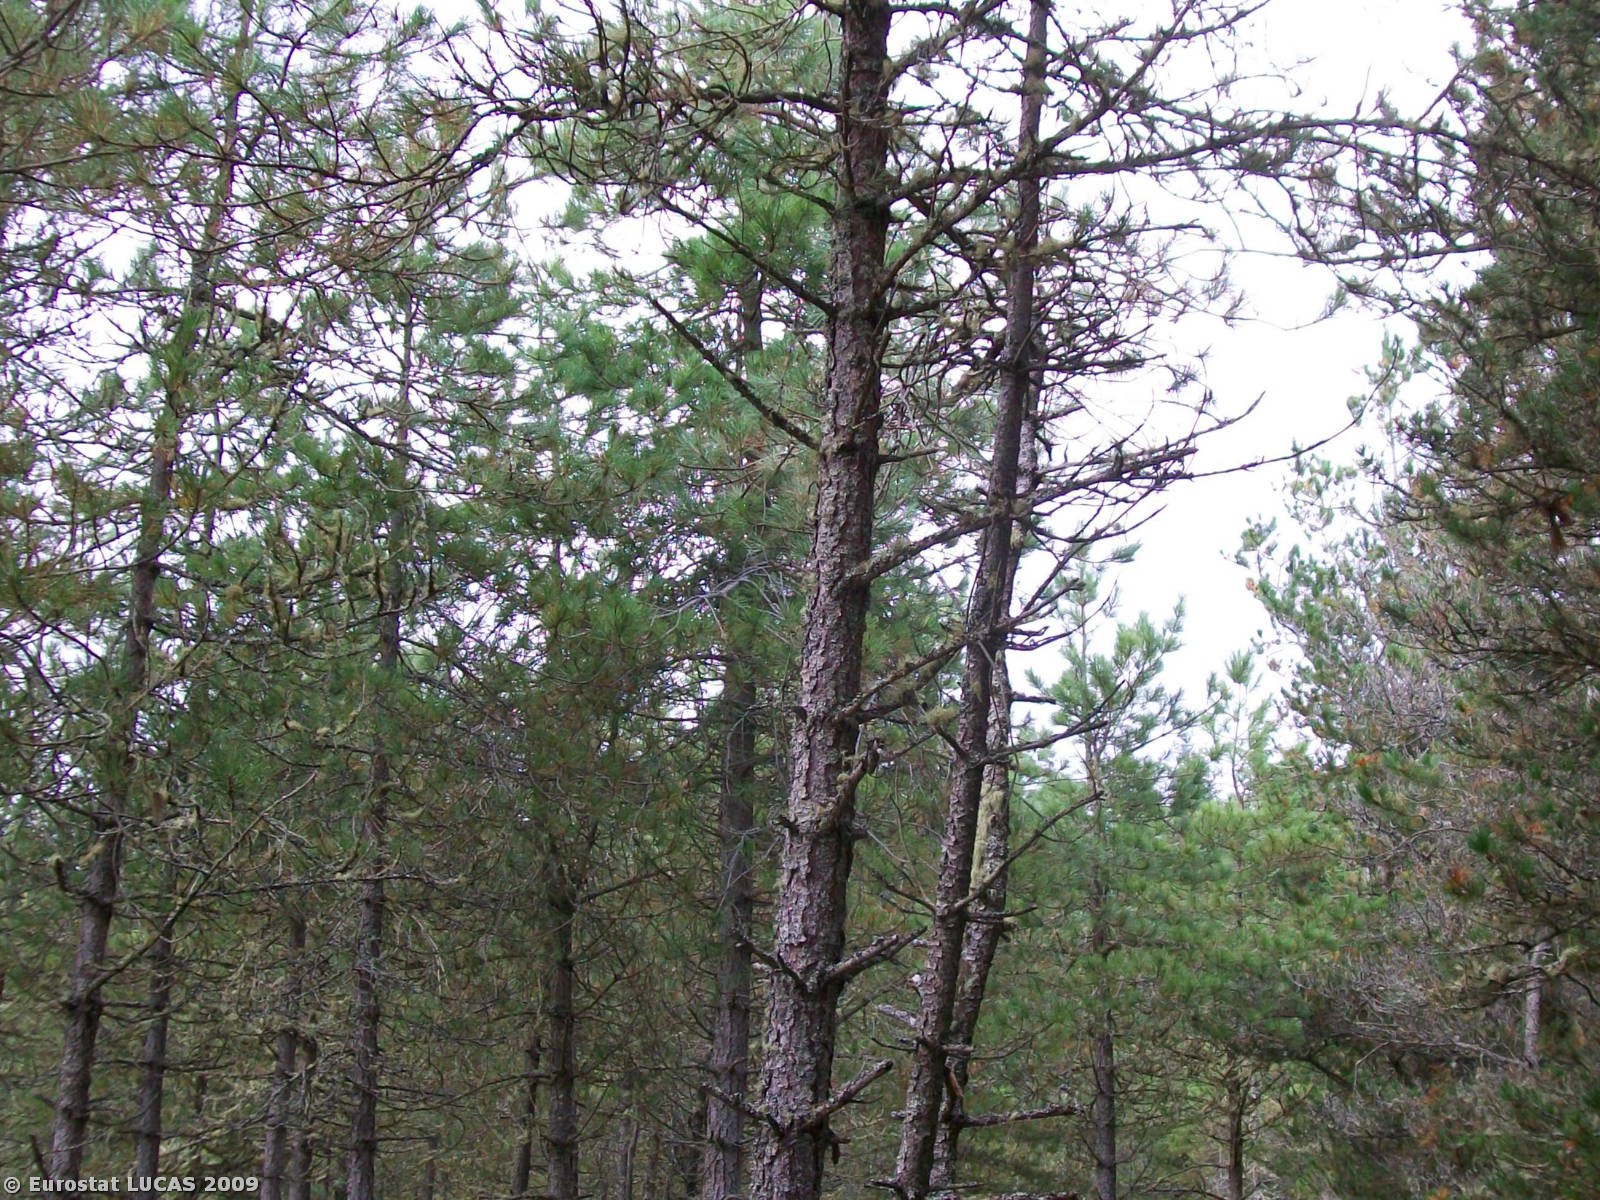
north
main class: Woodland
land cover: Coniferous woodland
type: plantations and self-sown exotic forest
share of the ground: 50 - 75 %
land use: Forestry
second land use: Amenities, museums, leisure
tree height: > 5 m
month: August
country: GB
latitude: 58.6112
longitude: -3.3326
